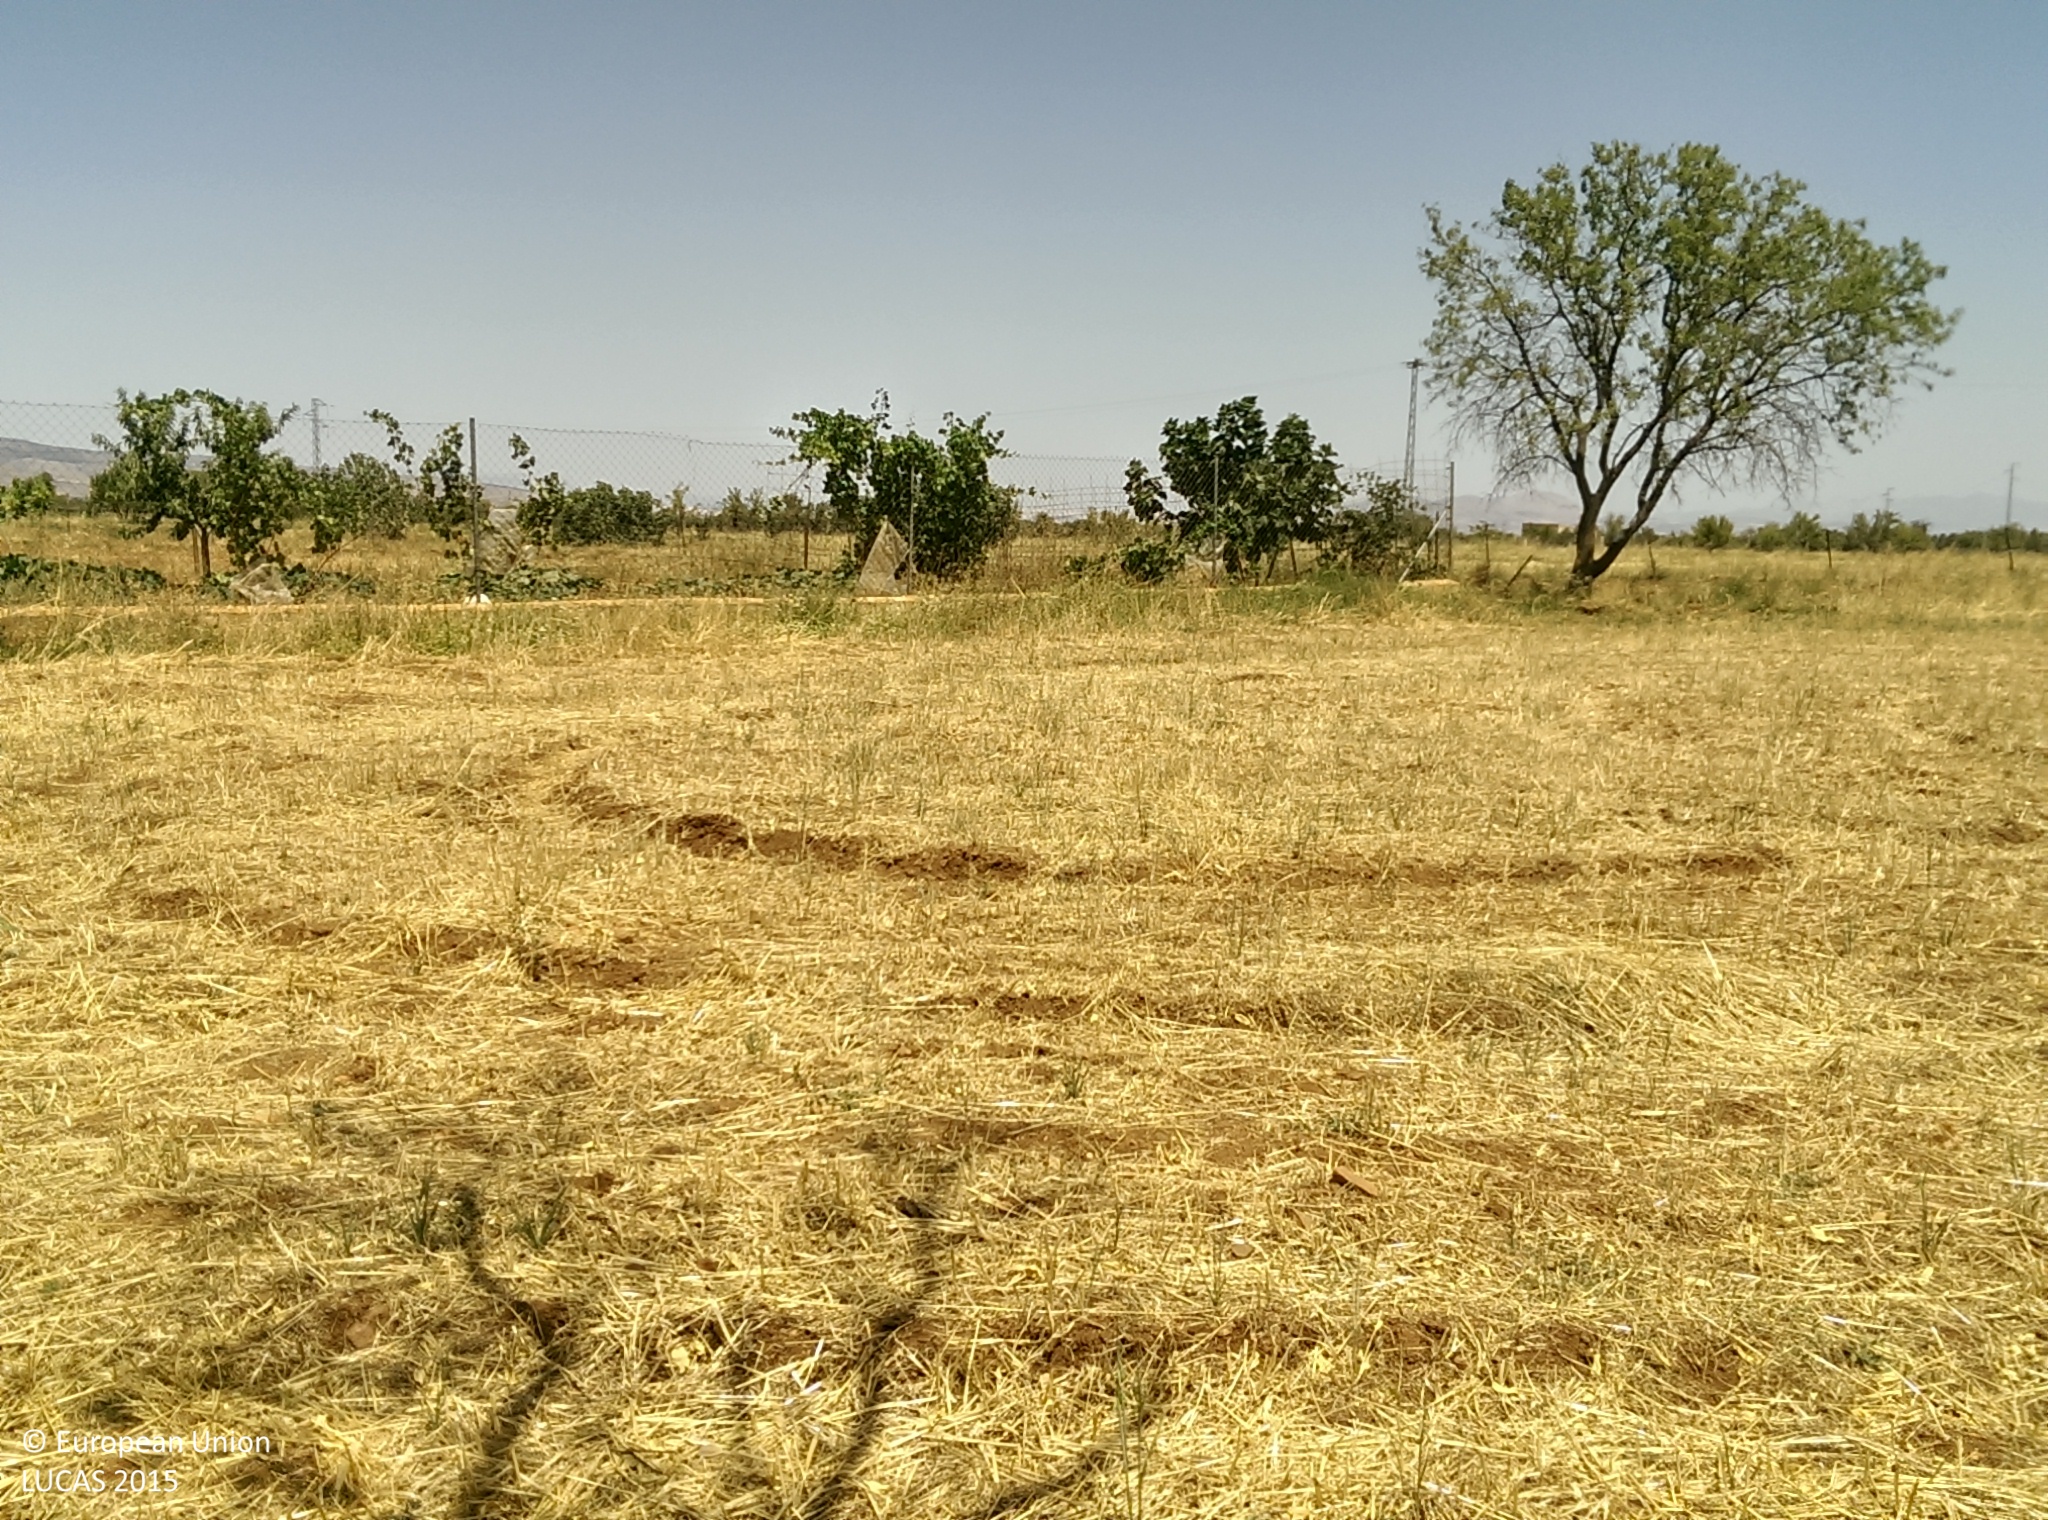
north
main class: Cropland
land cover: Barley
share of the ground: < 10 %
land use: Agriculture (excluding fallow land and kitchen gardens)
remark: Harvested field
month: July
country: ES
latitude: 37.2584
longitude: -3.2357
